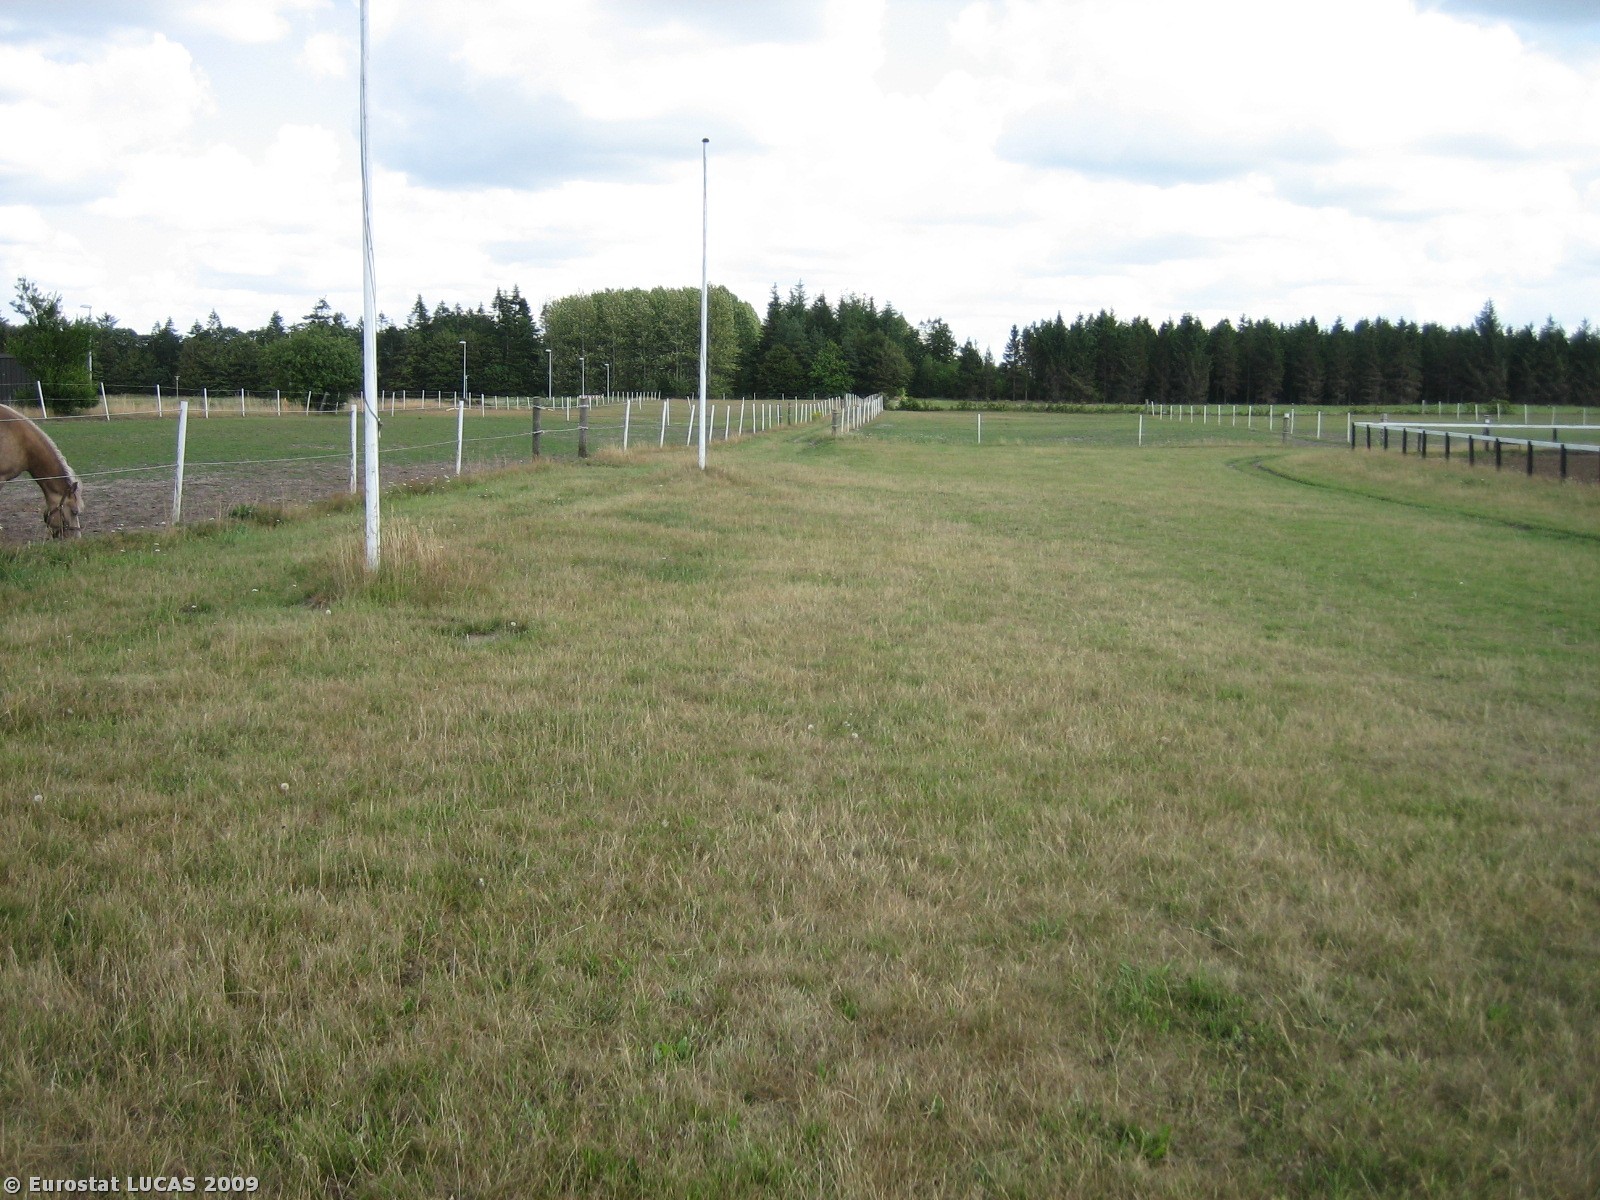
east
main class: Grassland
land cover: Grassland without tree/shrub cover
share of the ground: > 75 %
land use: Amenities, museums, leisure
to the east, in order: Grassland without tree/shrub cover; Fences; Grassland without tree/shrub cover; Fences; Grassland without tree/shrub cover; Fences; Grassland without tree/shrub cover; Paved roads, cycling and walking lanes
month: July
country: DK
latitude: 55.7521
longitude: 8.9654
